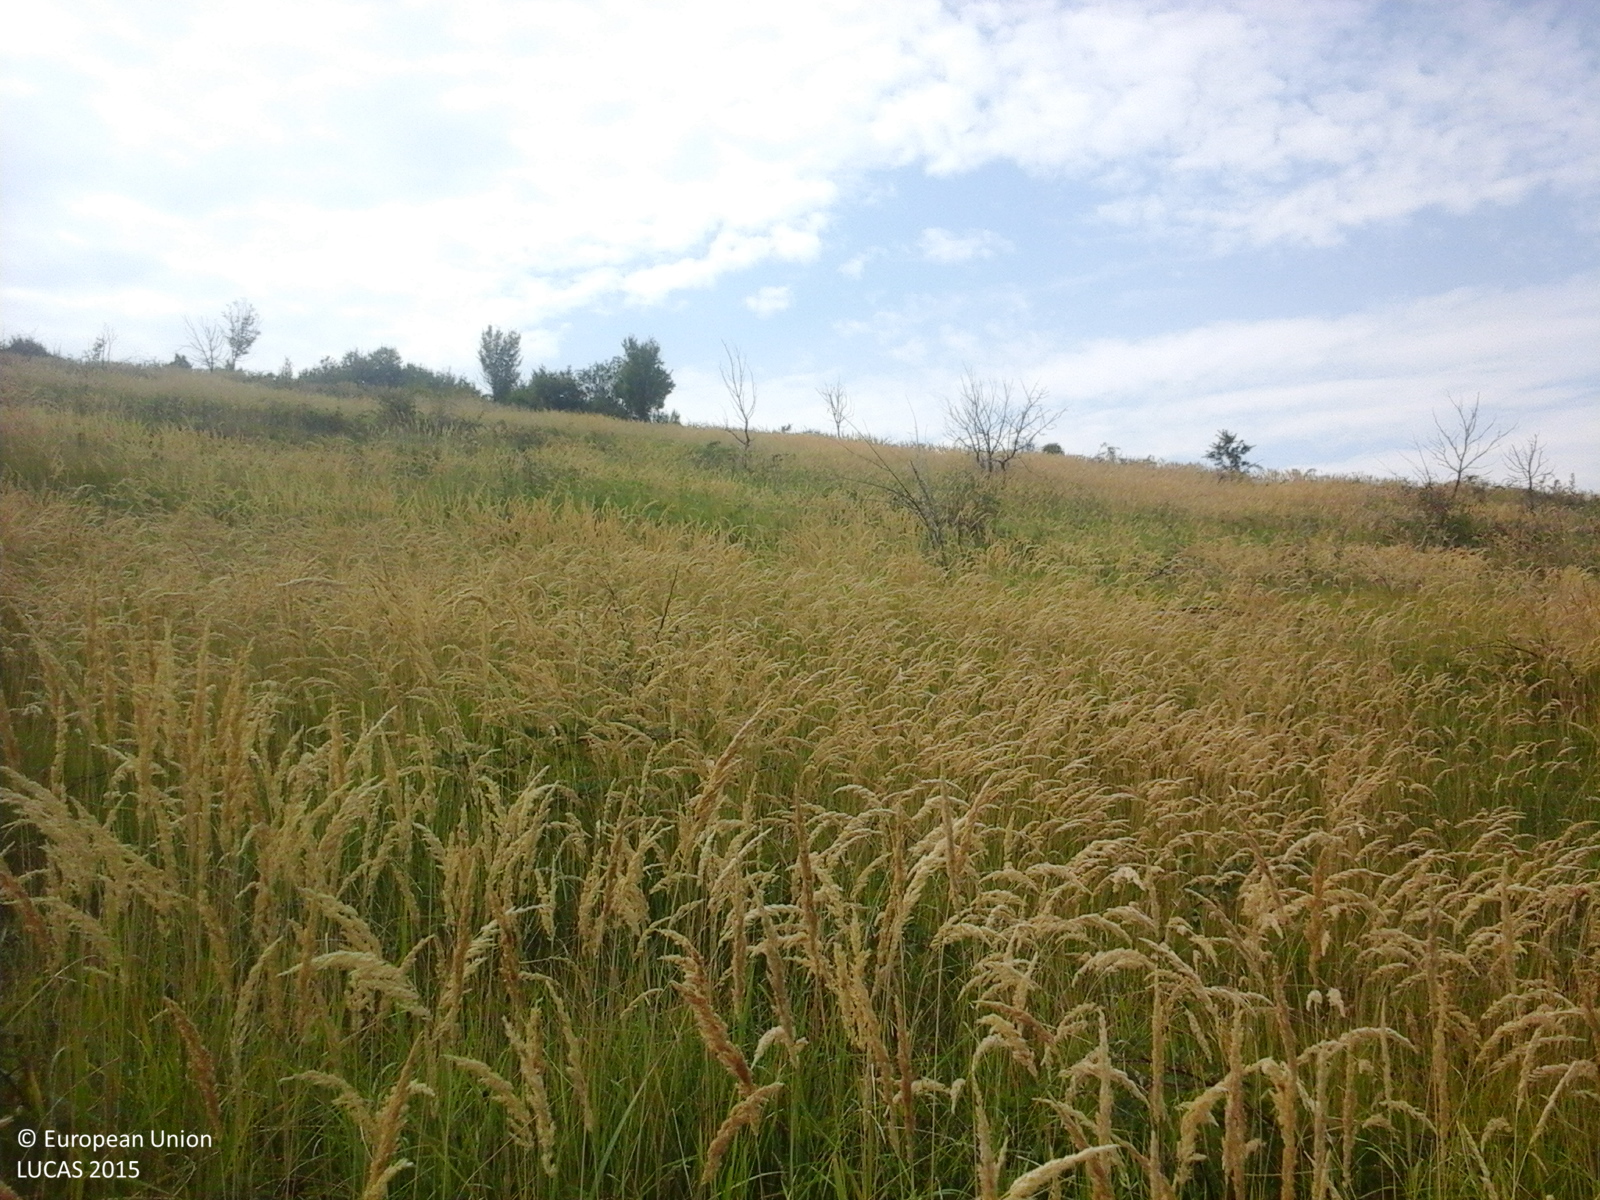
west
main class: Grassland
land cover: Grassland with sparse tree/shrub cover
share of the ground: > 75 %
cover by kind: herbaceous plants 85 %, shrubs 10 %, broadleaved forest trees 5 %
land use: Fallow land
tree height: < 5 m
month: September
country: RO
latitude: 45.7377
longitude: 22.8395
